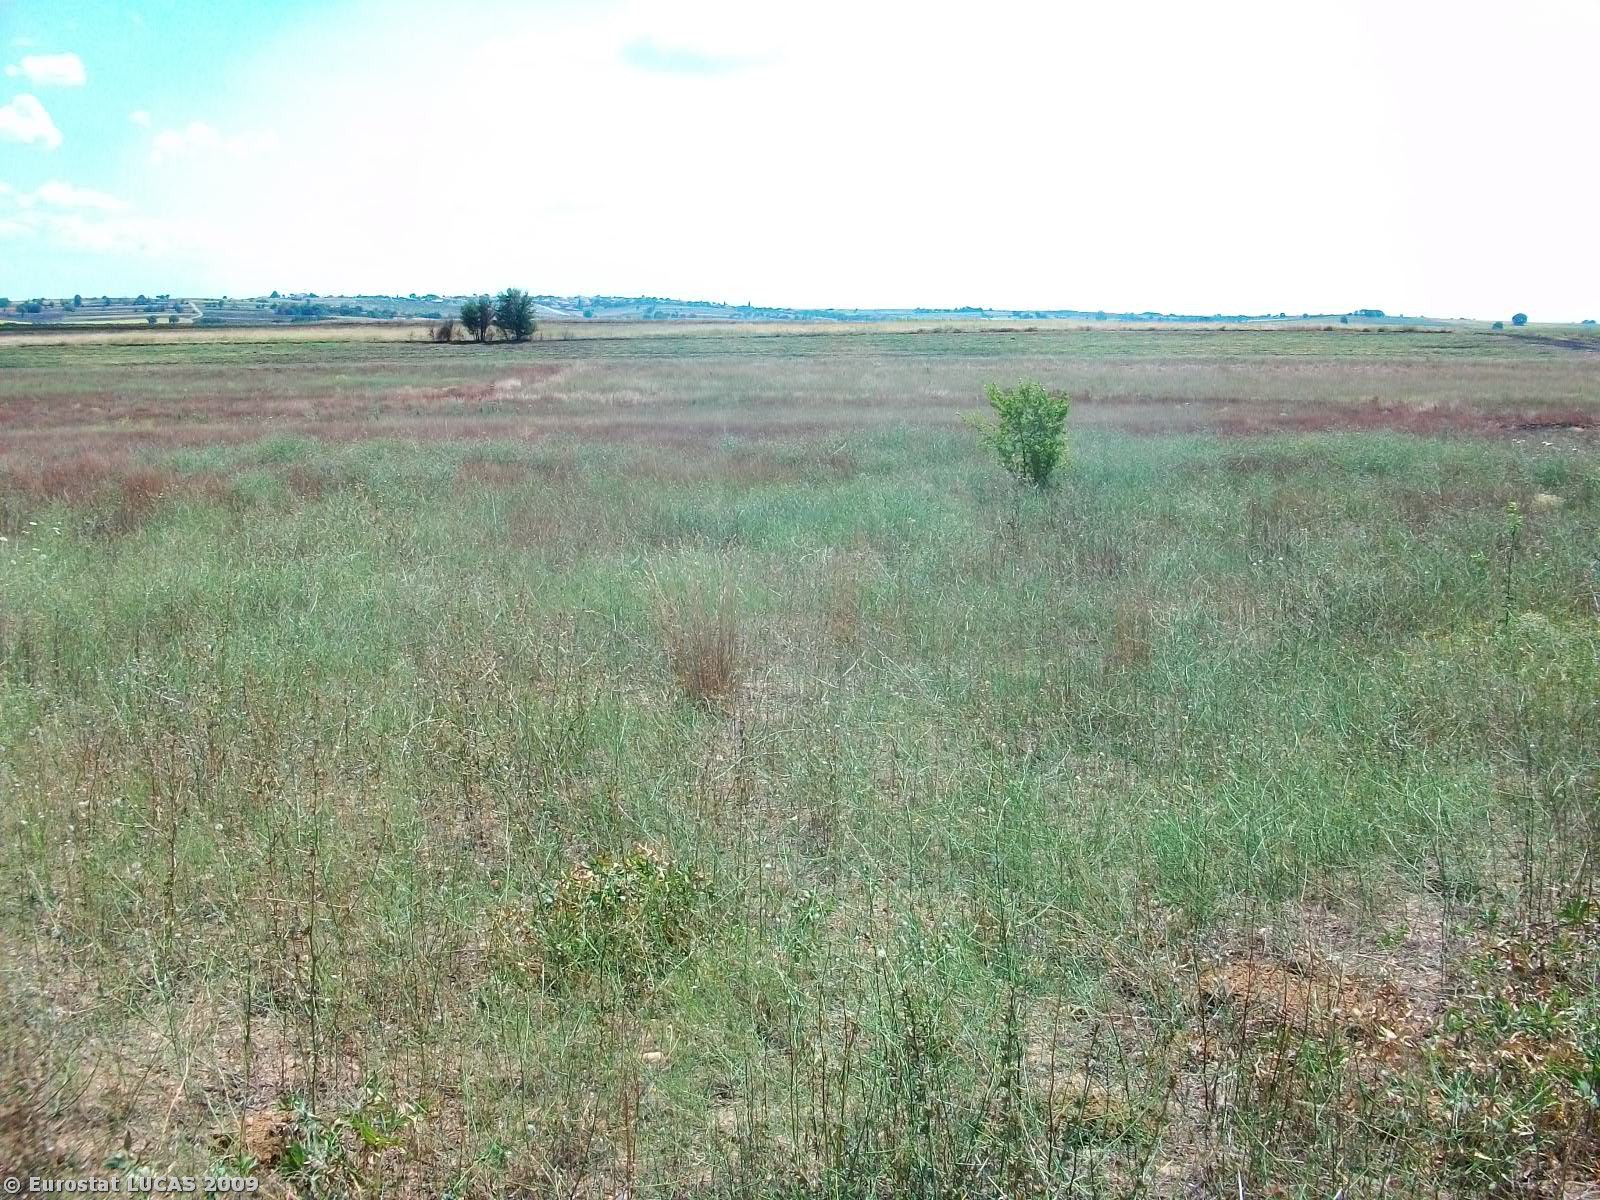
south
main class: Grassland
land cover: Grassland without tree/shrub cover
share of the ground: 50 - 75 %
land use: Unused
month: August
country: GR
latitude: 41.5078
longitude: 26.4067
